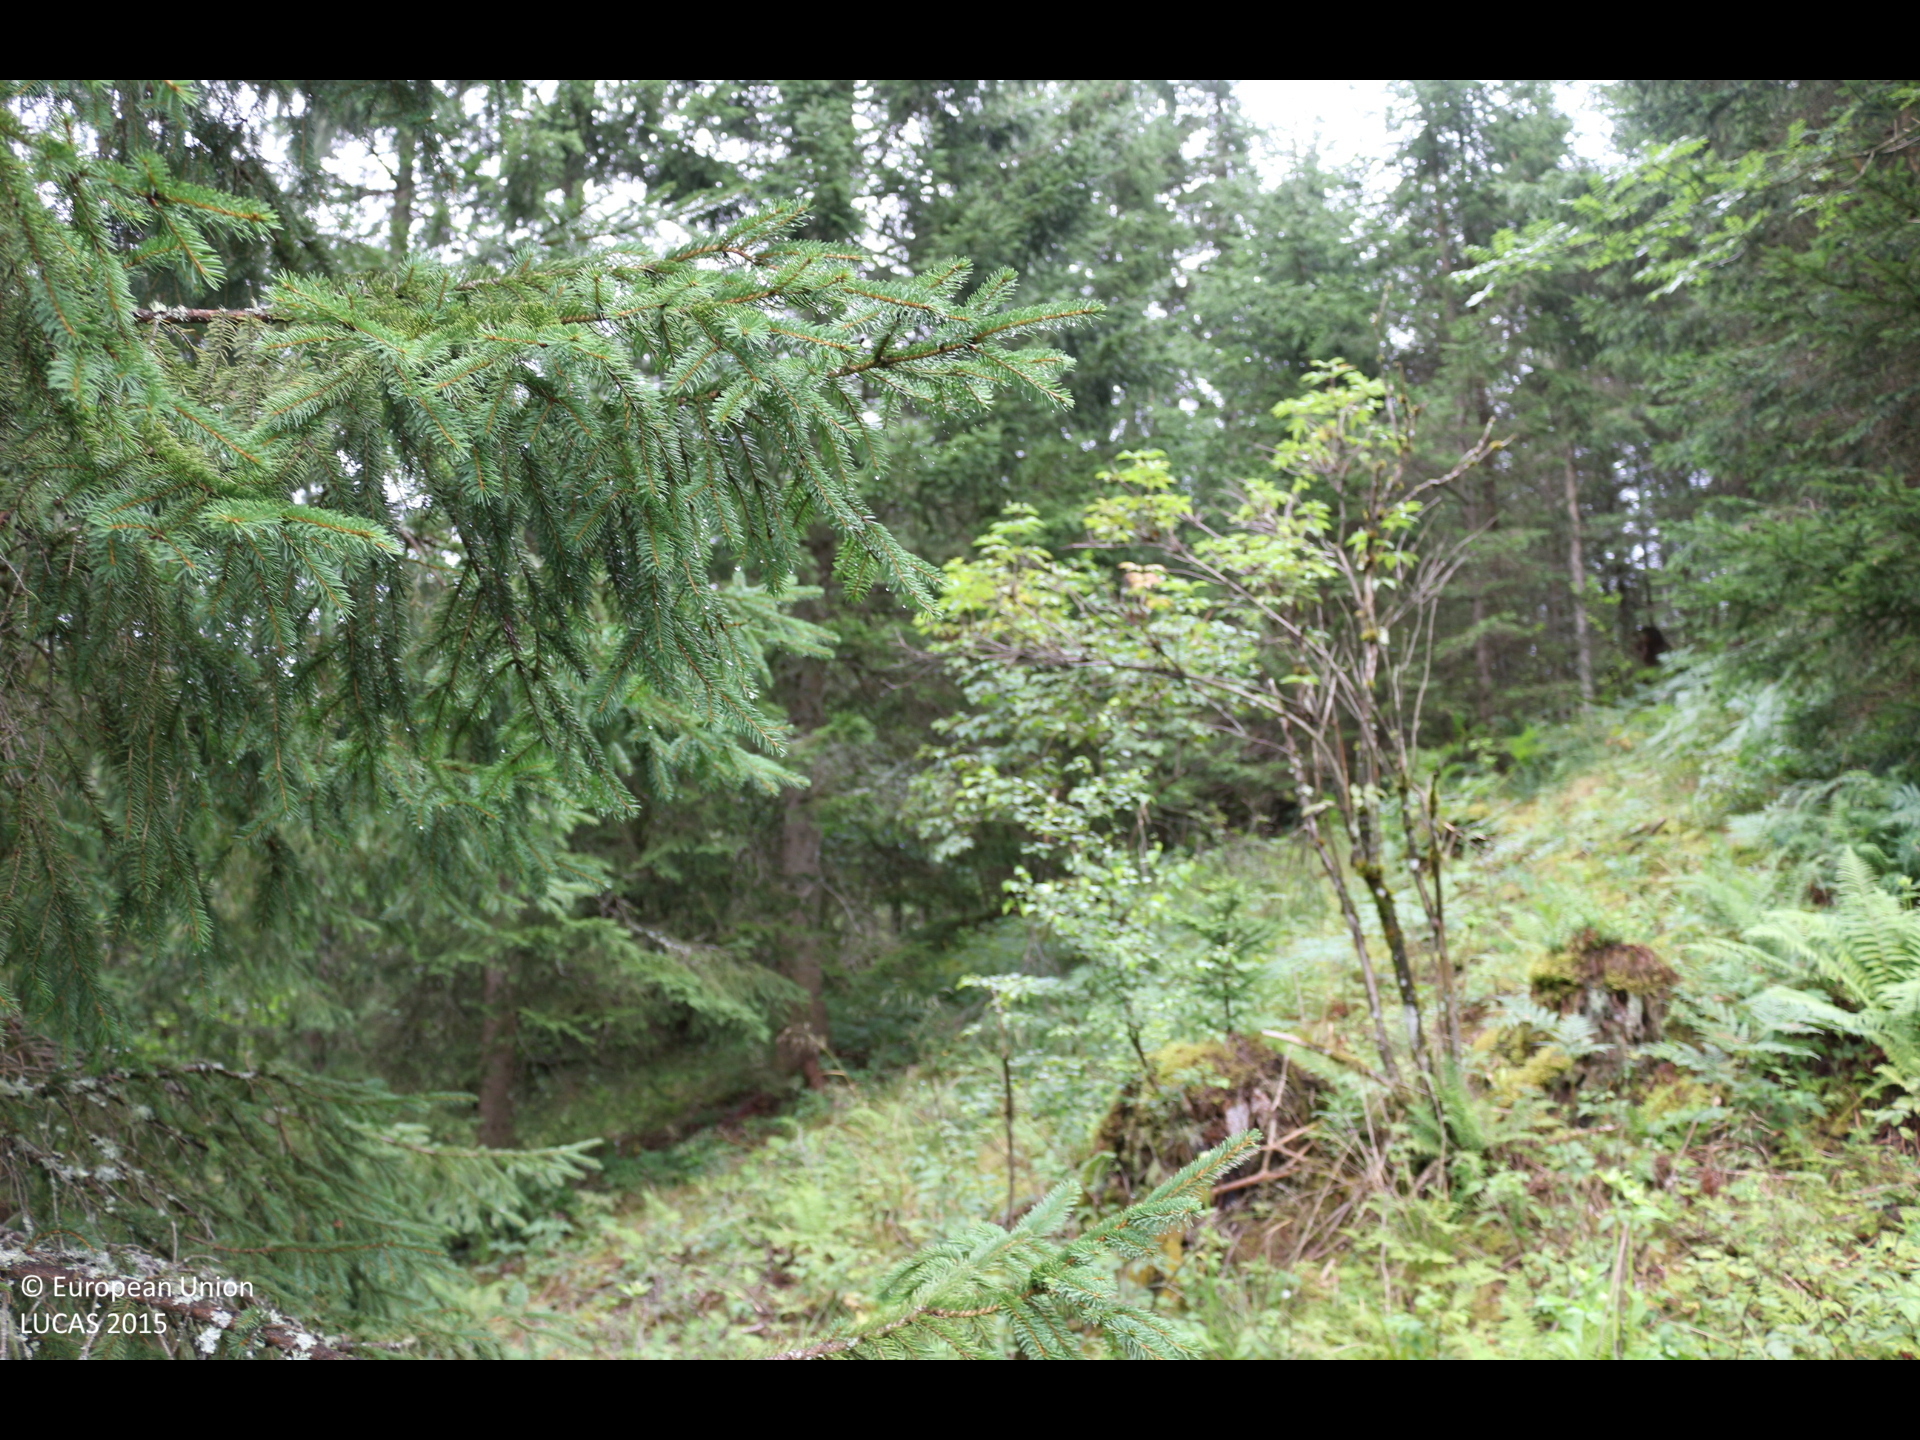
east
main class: Woodland
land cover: Spruce dominated coniferous woodland
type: alpine coniferous forest
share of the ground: > 75 %
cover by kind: coniferous forest trees 90 %, shrubs 5 %, herbaceous plants 5 %
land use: Forestry
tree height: > 5 m
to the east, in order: Spruce dominated coniferous woodland; Rivers and streams; Spruce dominated coniferous woodland; Tracks; Spruce dominated coniferous woodland; Tracks; Spruce dominated coniferous woodland; Tracks; Spruce dominated coniferous woodland; Tracks; Spruce dominated coniferous woodland; Other mixed woodland
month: July
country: AT
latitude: 46.9344
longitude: 14.2406
